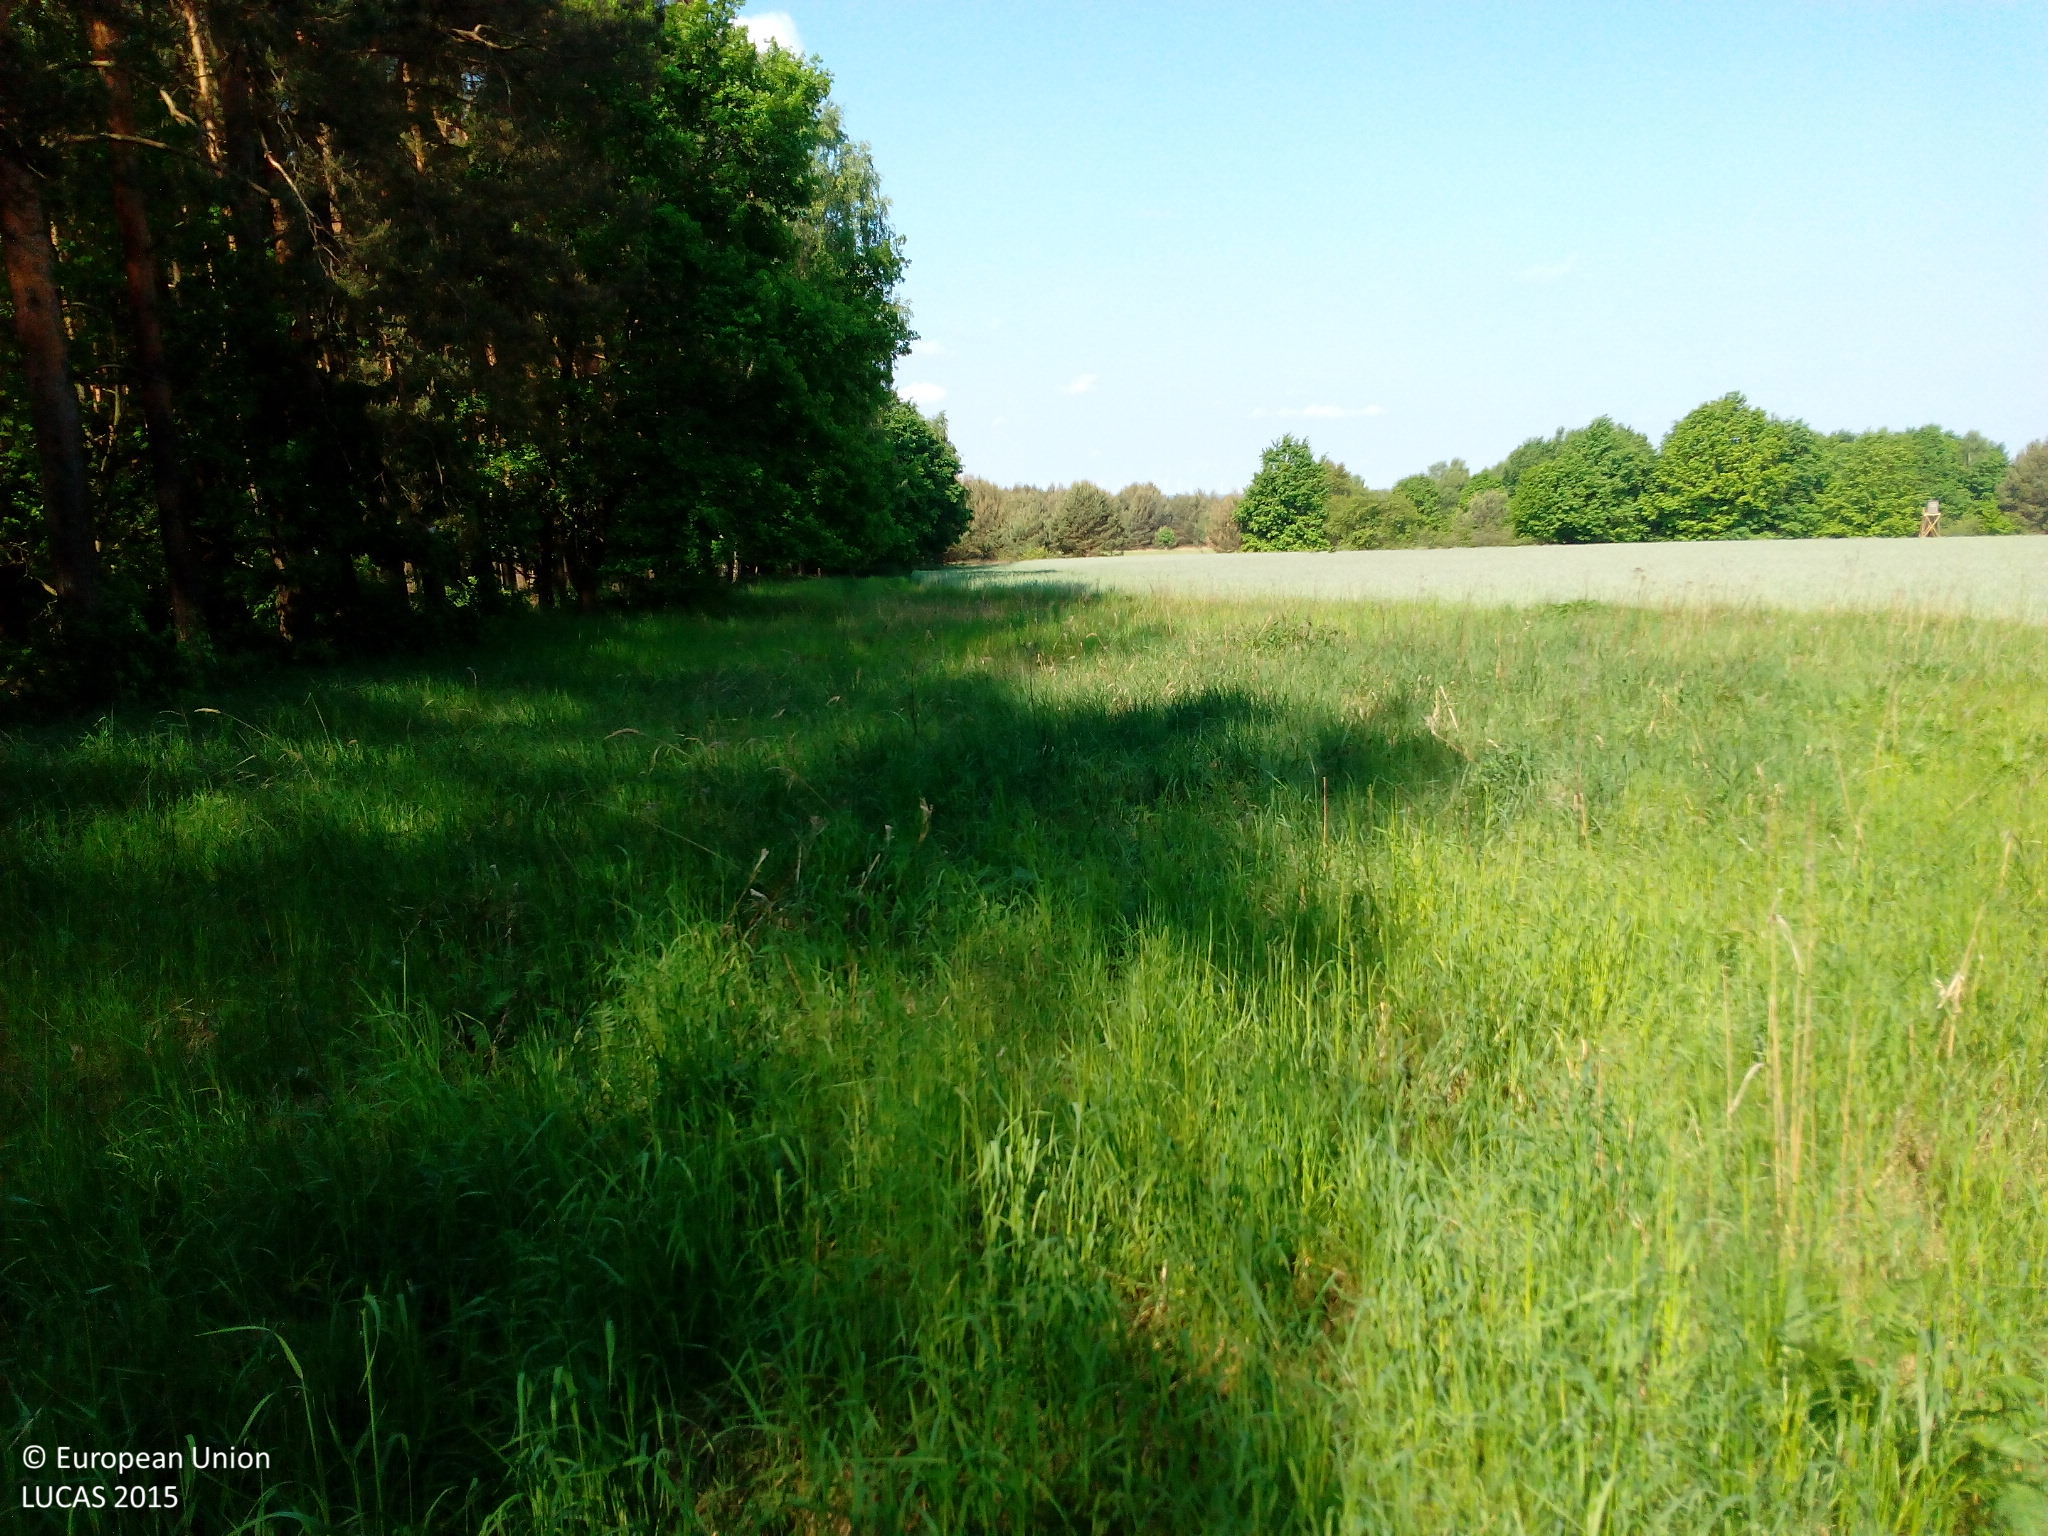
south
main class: Grassland
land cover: Grassland without tree/shrub cover
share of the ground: > 75 %
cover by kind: herbaceous plants 100 %
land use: Agriculture (excluding fallow land and kitchen gardens)
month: May
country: DE
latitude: 52.0303
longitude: 13.1338
